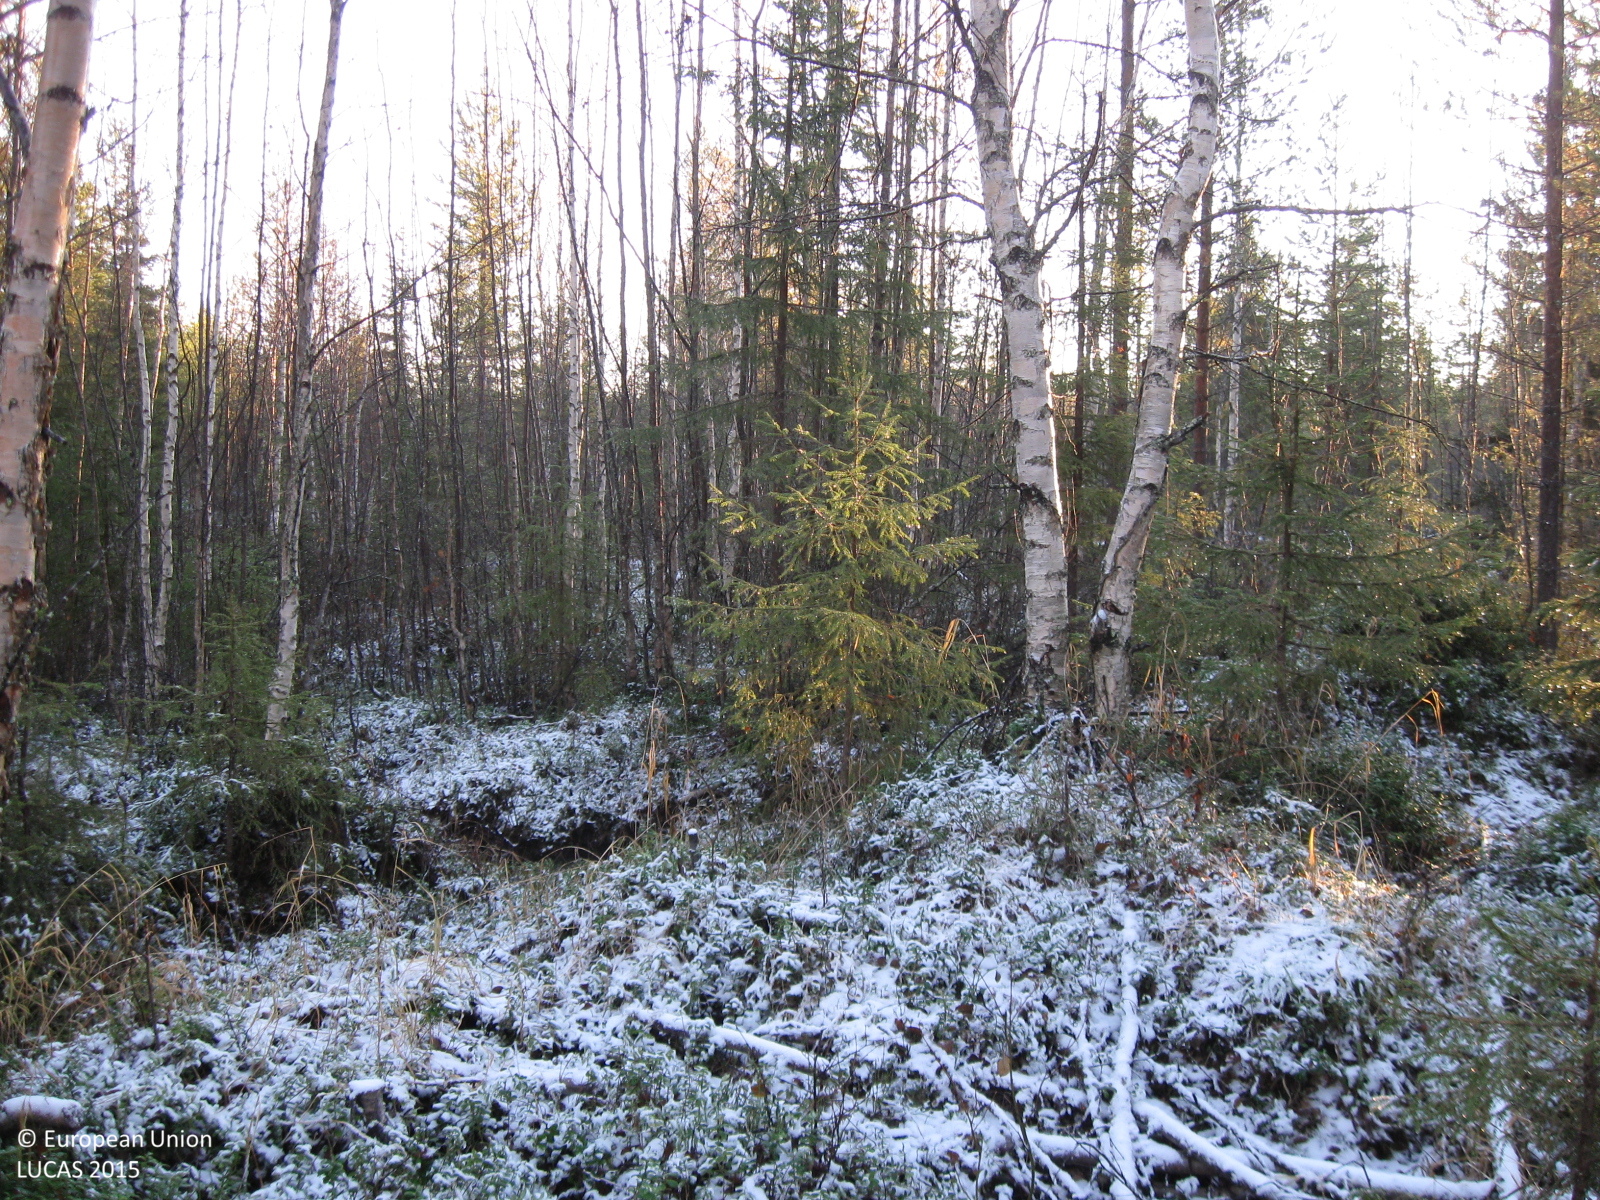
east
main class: Woodland
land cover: Spruce dominated mixed woodland
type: mire and swamp forests
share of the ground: > 75 %
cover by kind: broadleaved forest trees 55 %, coniferous forest trees 20 %, herbaceous plants 15 %, shrubs 10 %
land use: Forestry
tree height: > 5 m
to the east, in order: Spruce dominated mixed woodland; Ditches and canals; Spruce dominated mixed woodland; Ditches and canals; Pine dominated mixed woodland; Pine dominated coniferous woodland; Other mixed woodland; Spruce dominated mixed woodland
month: October
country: SE
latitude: 66.3094
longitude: 20.8669
